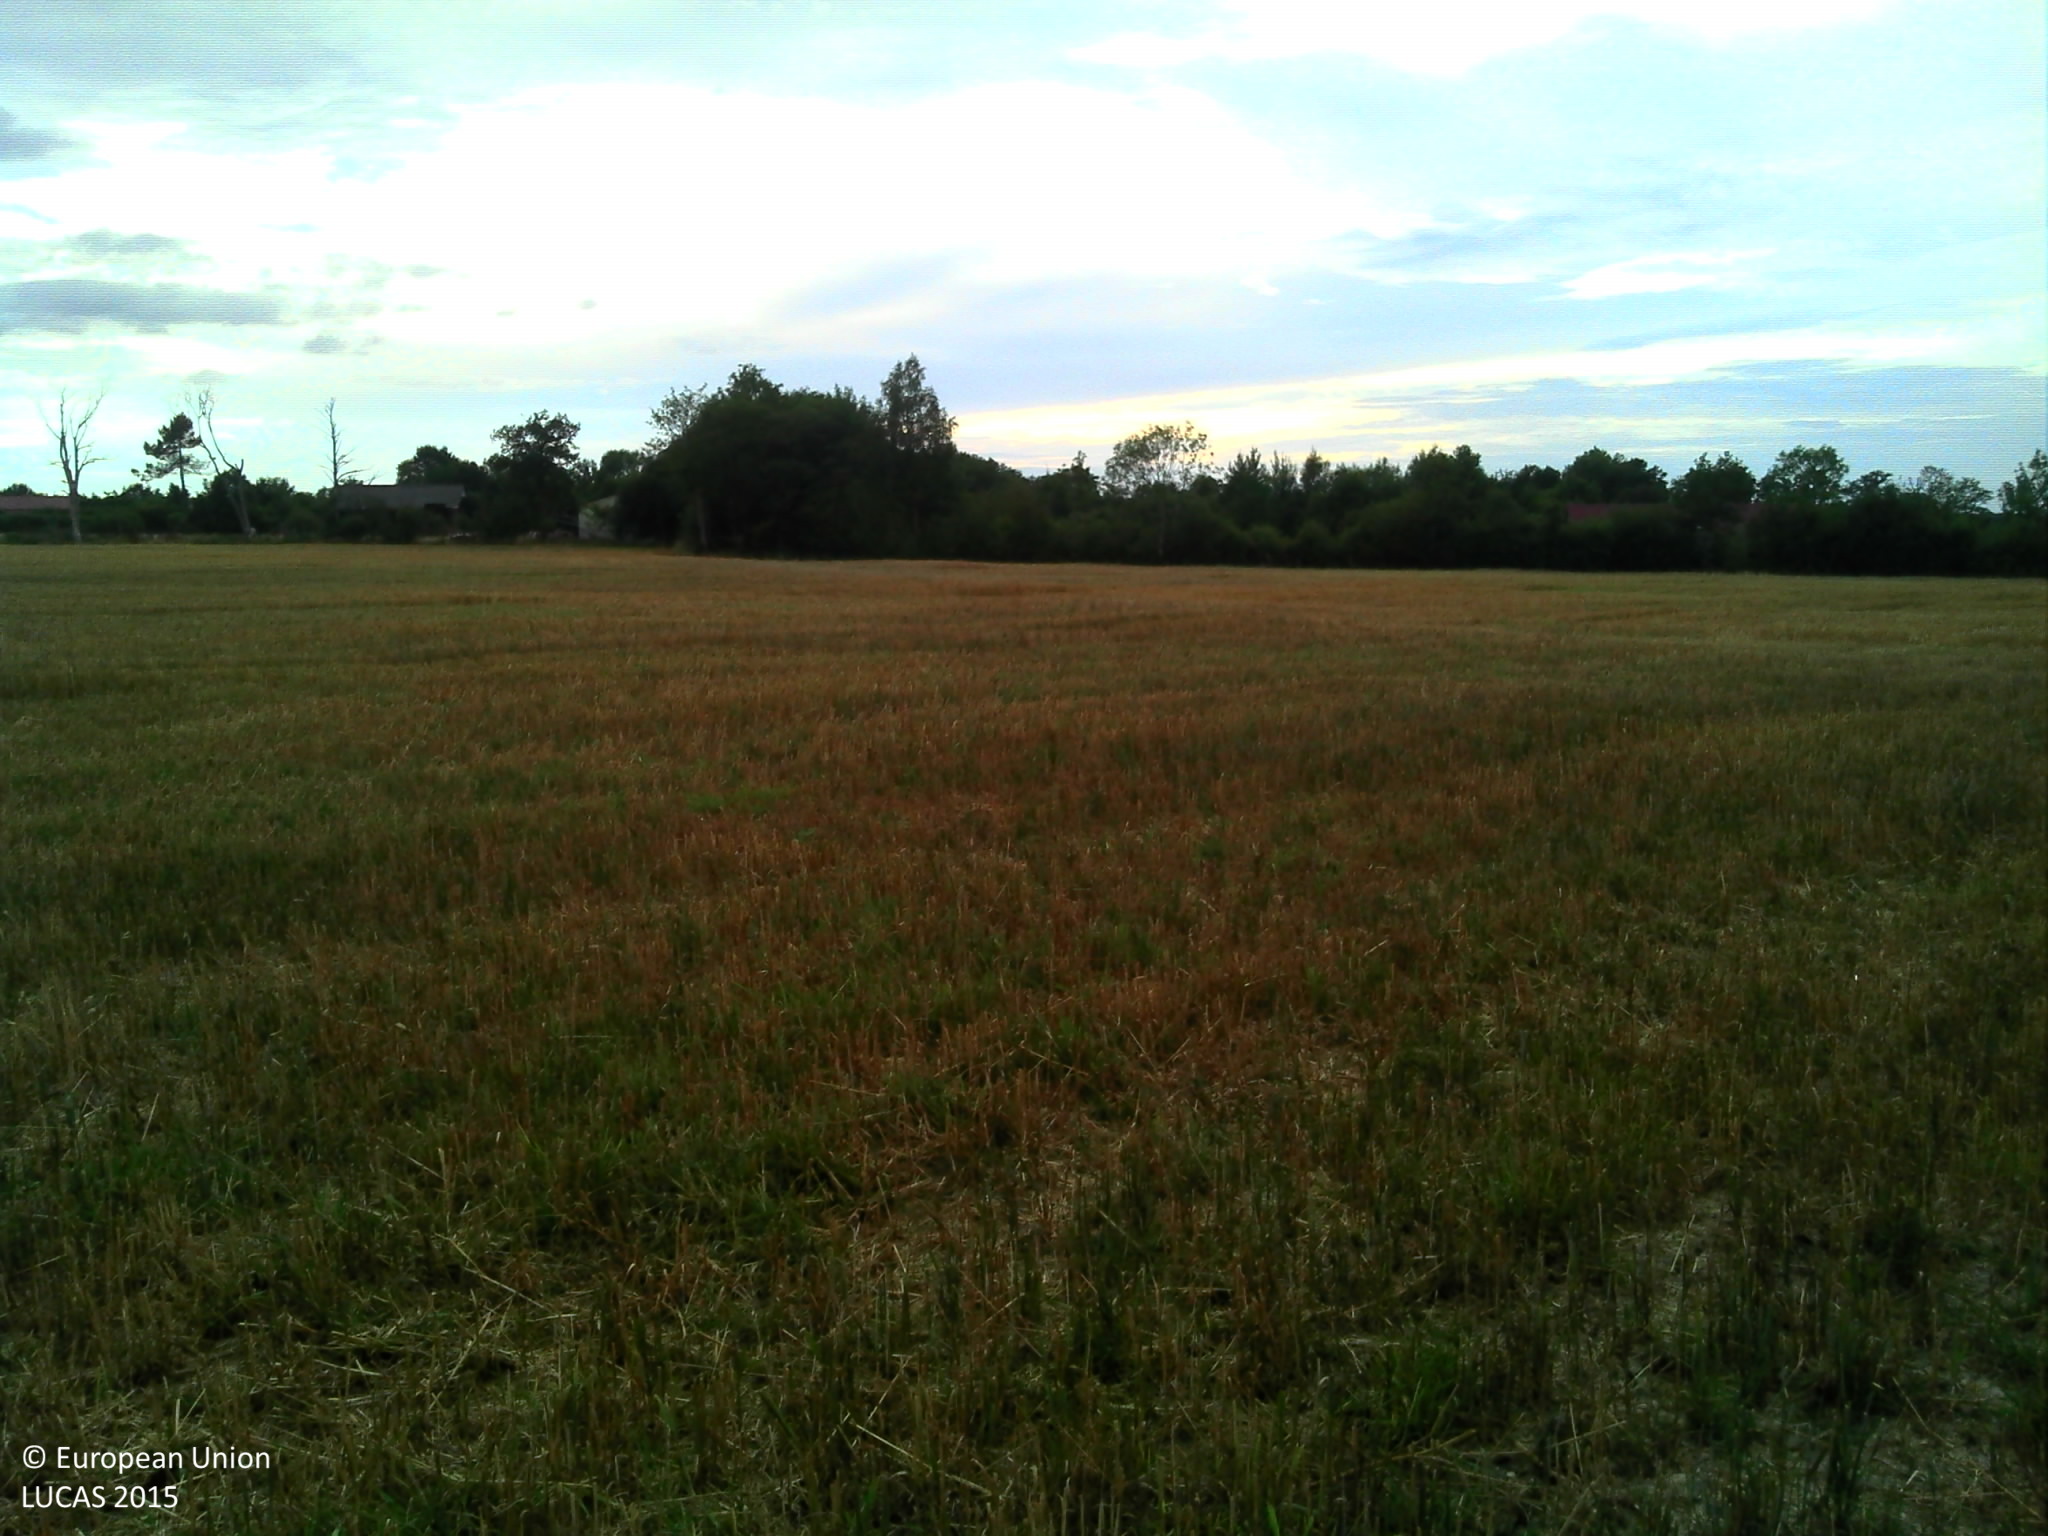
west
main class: Cropland
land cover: Oats
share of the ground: > 75 %
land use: Agriculture (excluding fallow land and kitchen gardens)
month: July
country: FR
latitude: 48.6958
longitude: 0.4504
